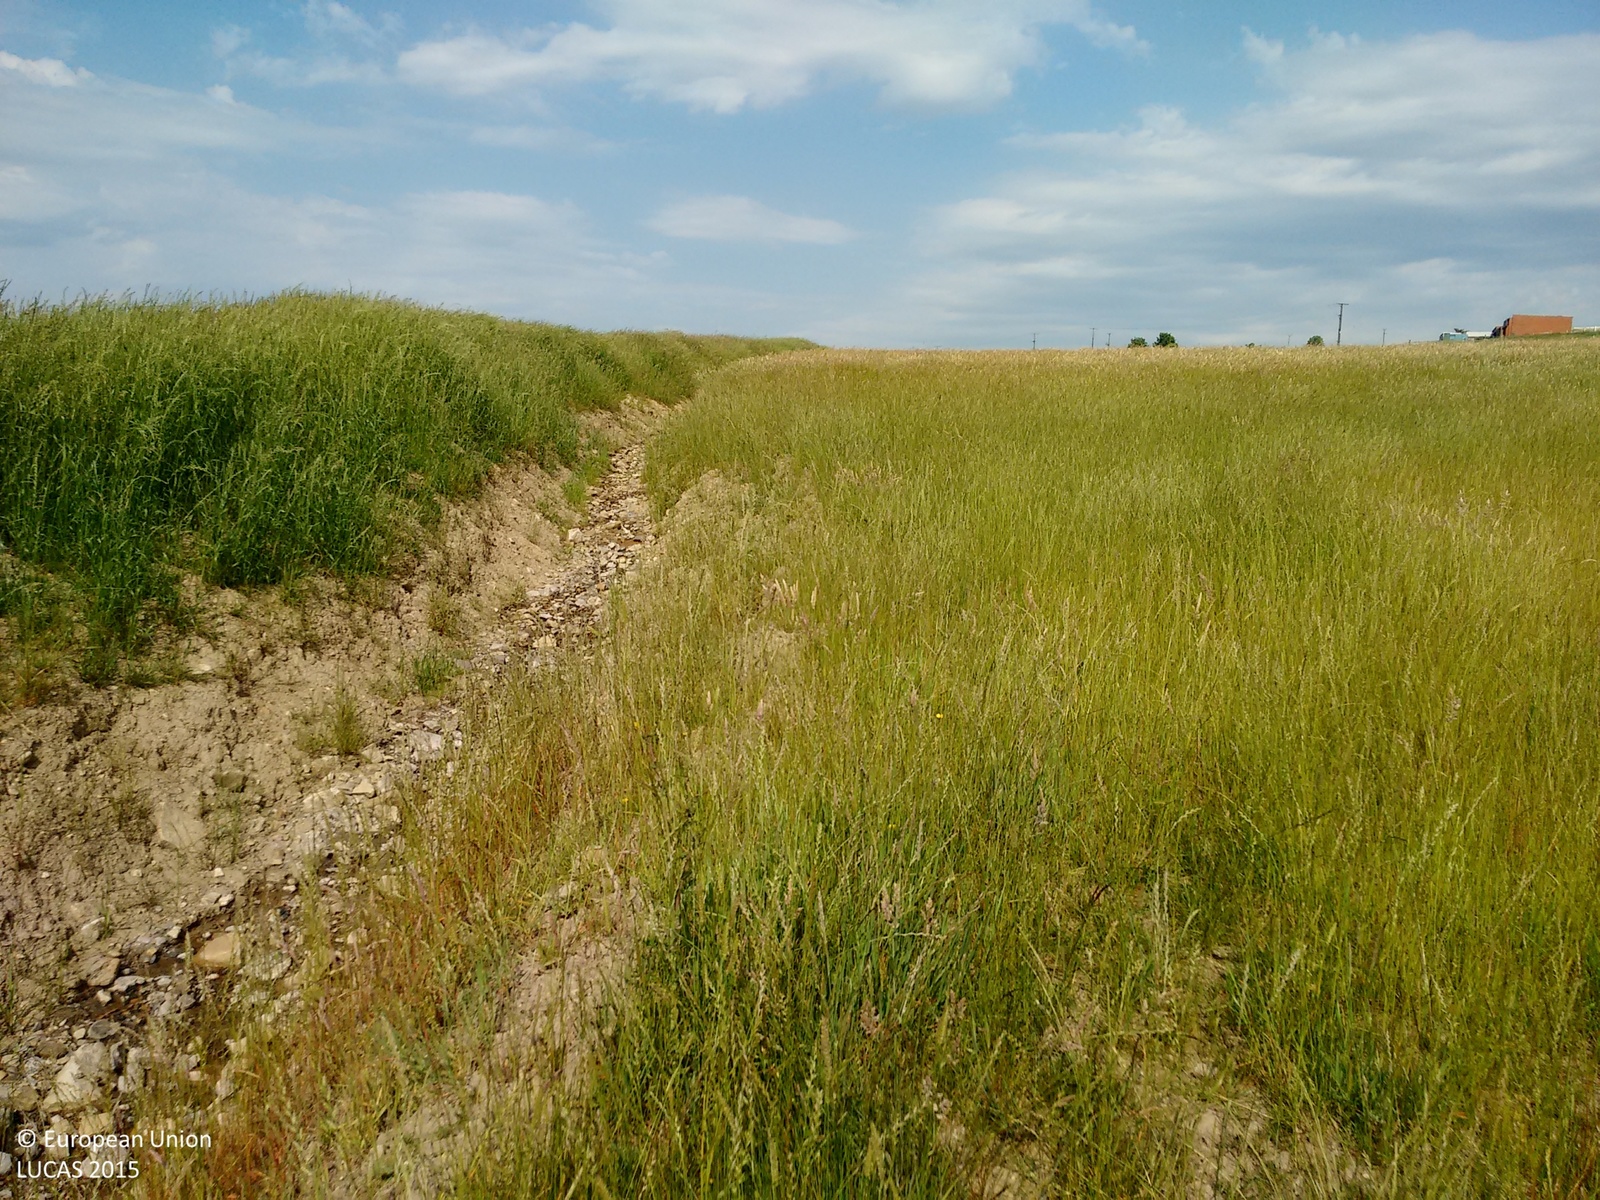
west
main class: Grassland
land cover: Grassland without tree/shrub cover
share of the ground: > 75 %
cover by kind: herbaceous plants 100 %
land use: Agriculture (excluding fallow land and kitchen gardens)
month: July
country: GB
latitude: 54.7338
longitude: -1.7772
